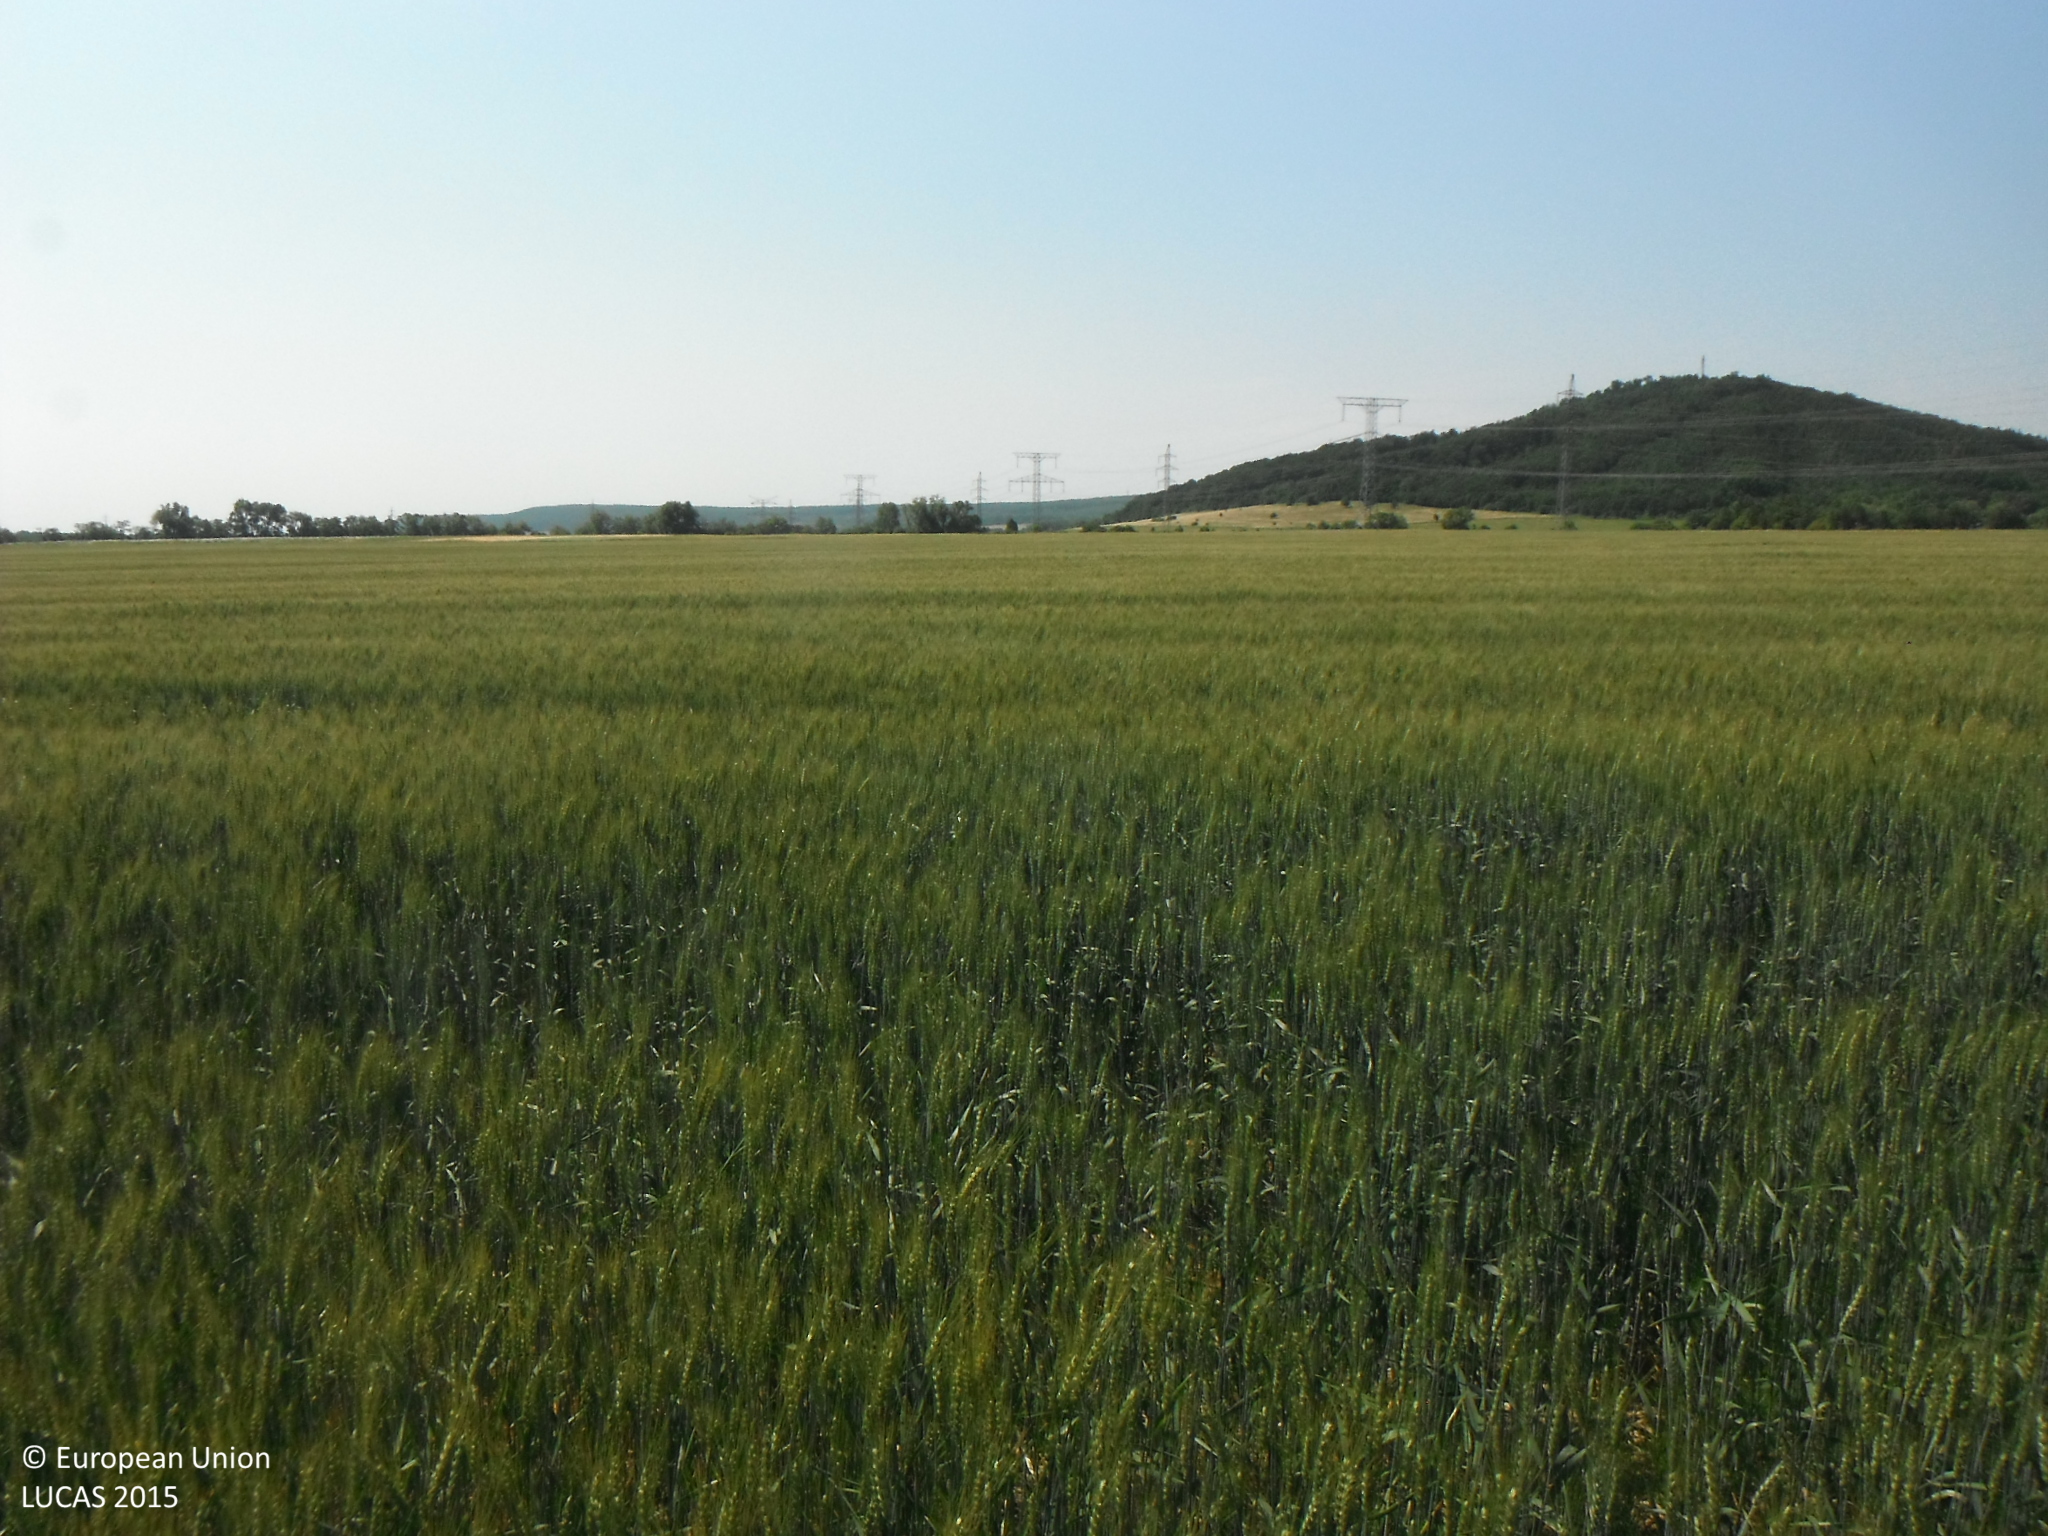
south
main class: Cropland
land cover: Common wheat
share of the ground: > 75 %
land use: Agriculture (excluding fallow land and kitchen gardens)
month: June
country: SK
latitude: 48.8023
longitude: 21.8294
